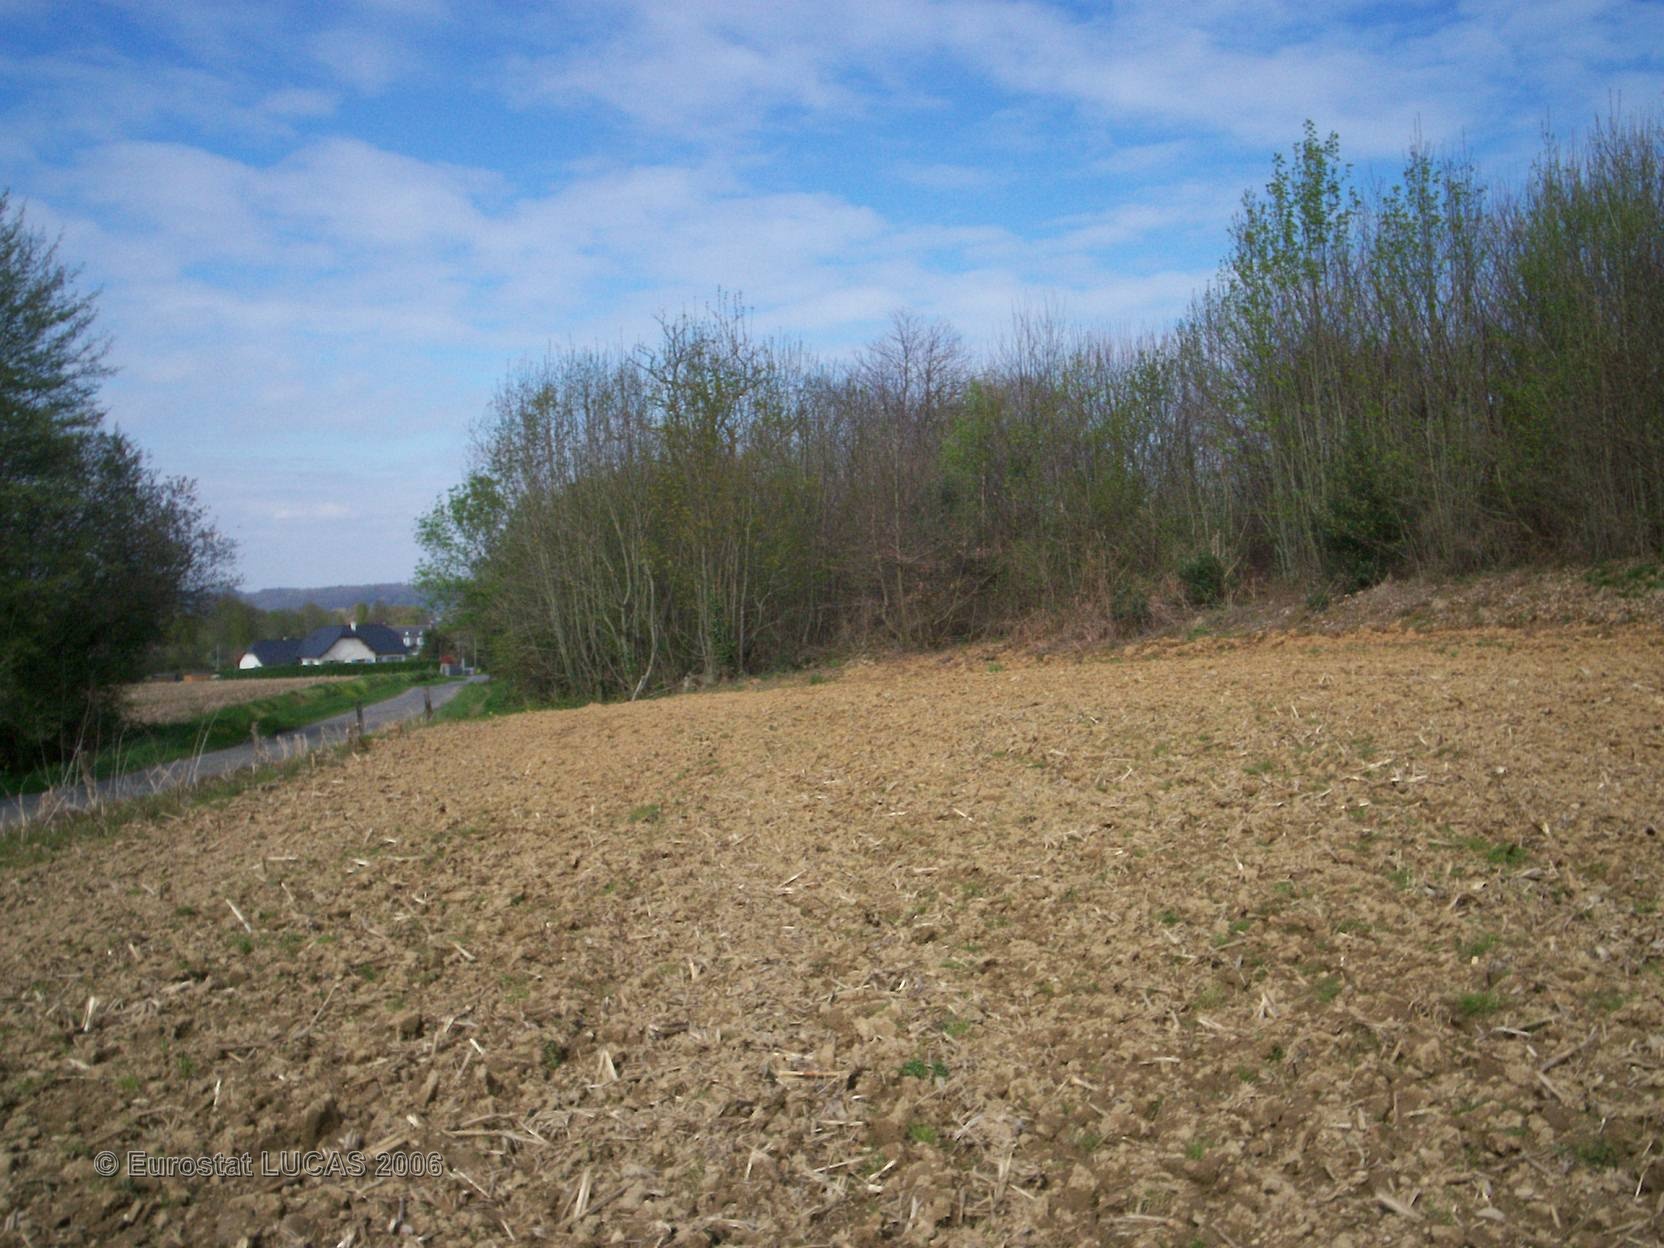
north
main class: Grassland
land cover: Grassland without tree/shrub cover
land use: Agriculture (excluding fallow land and kitchen gardens)
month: June
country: FR
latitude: 43.1635
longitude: -0.1264
